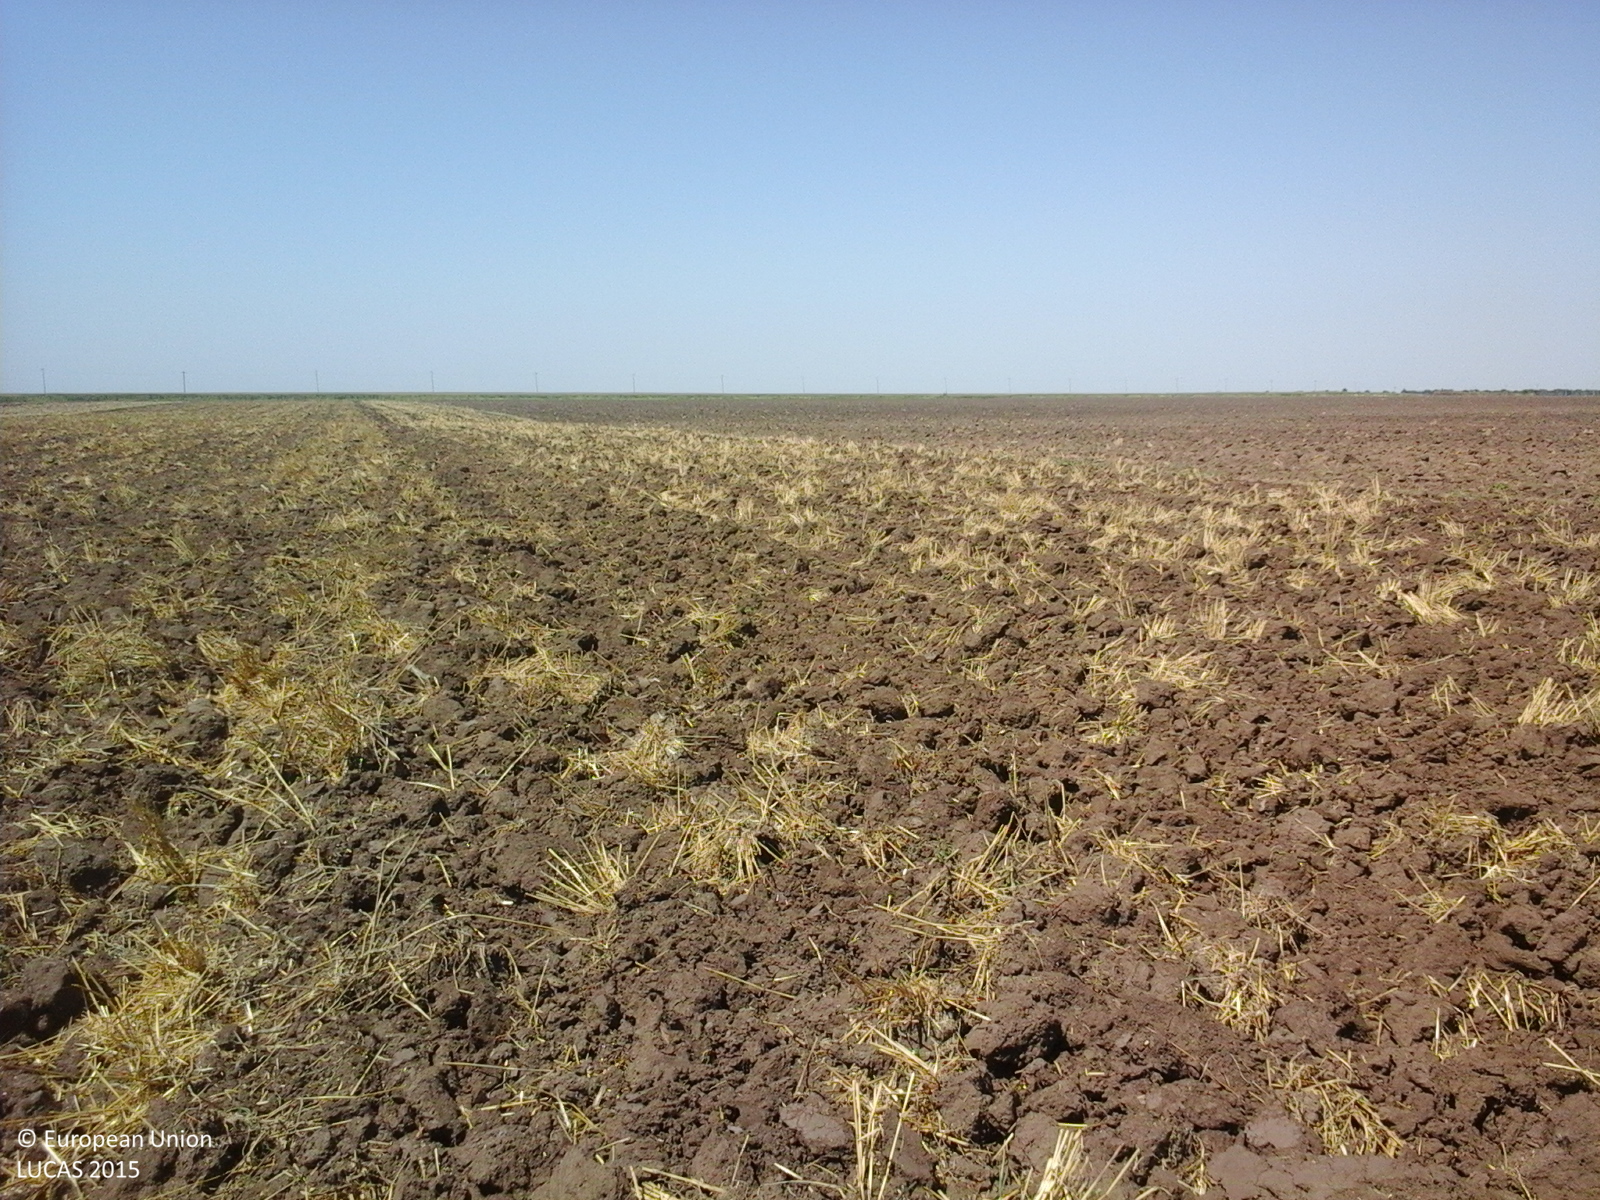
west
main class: Cropland
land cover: Durum wheat
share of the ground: < 10 %
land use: Agriculture (excluding fallow land and kitchen gardens)
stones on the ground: < 10 %
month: July
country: RO
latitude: 44.3446
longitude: 26.4831
